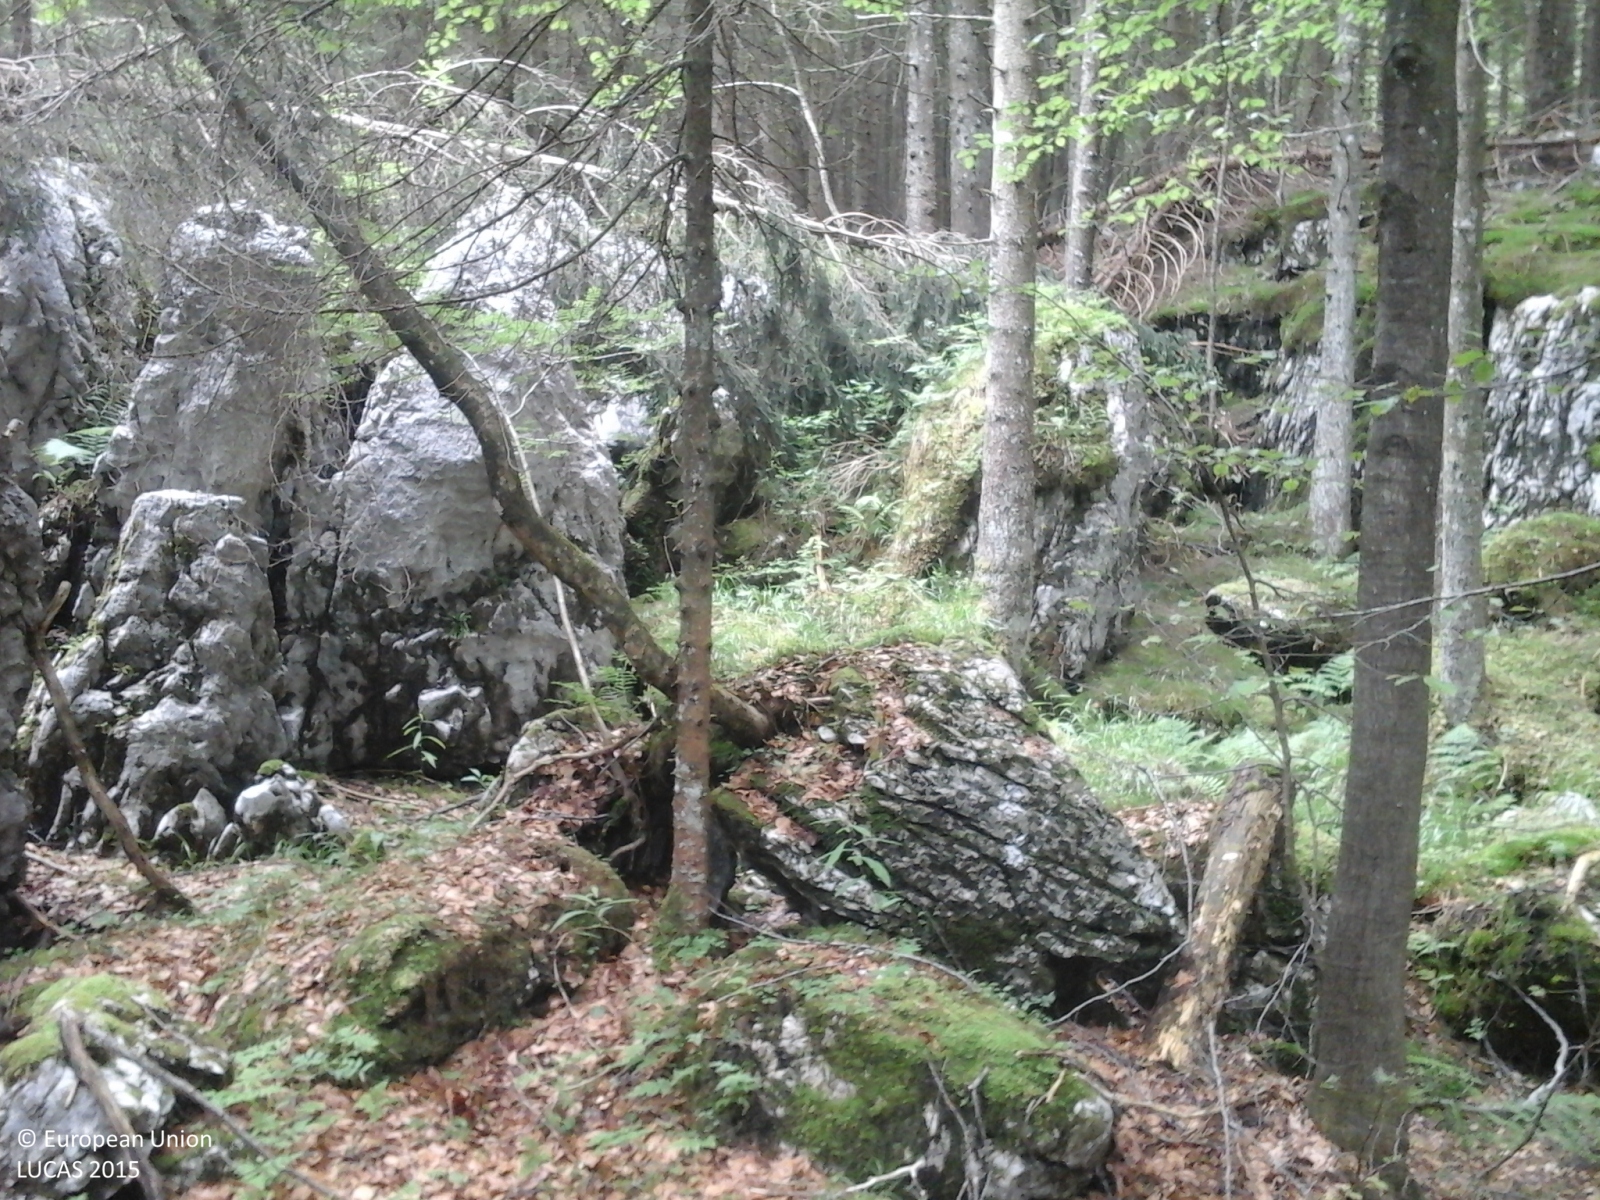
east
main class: Woodland
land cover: Spruce dominated mixed woodland
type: alpine coniferous forest
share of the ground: > 75 %
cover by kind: coniferous forest trees 75 %, broadleaved forest trees 25 %
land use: Forestry
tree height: > 5 m
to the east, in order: Spruce dominated mixed woodland
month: June
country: IT
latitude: 45.8177
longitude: 11.5293
